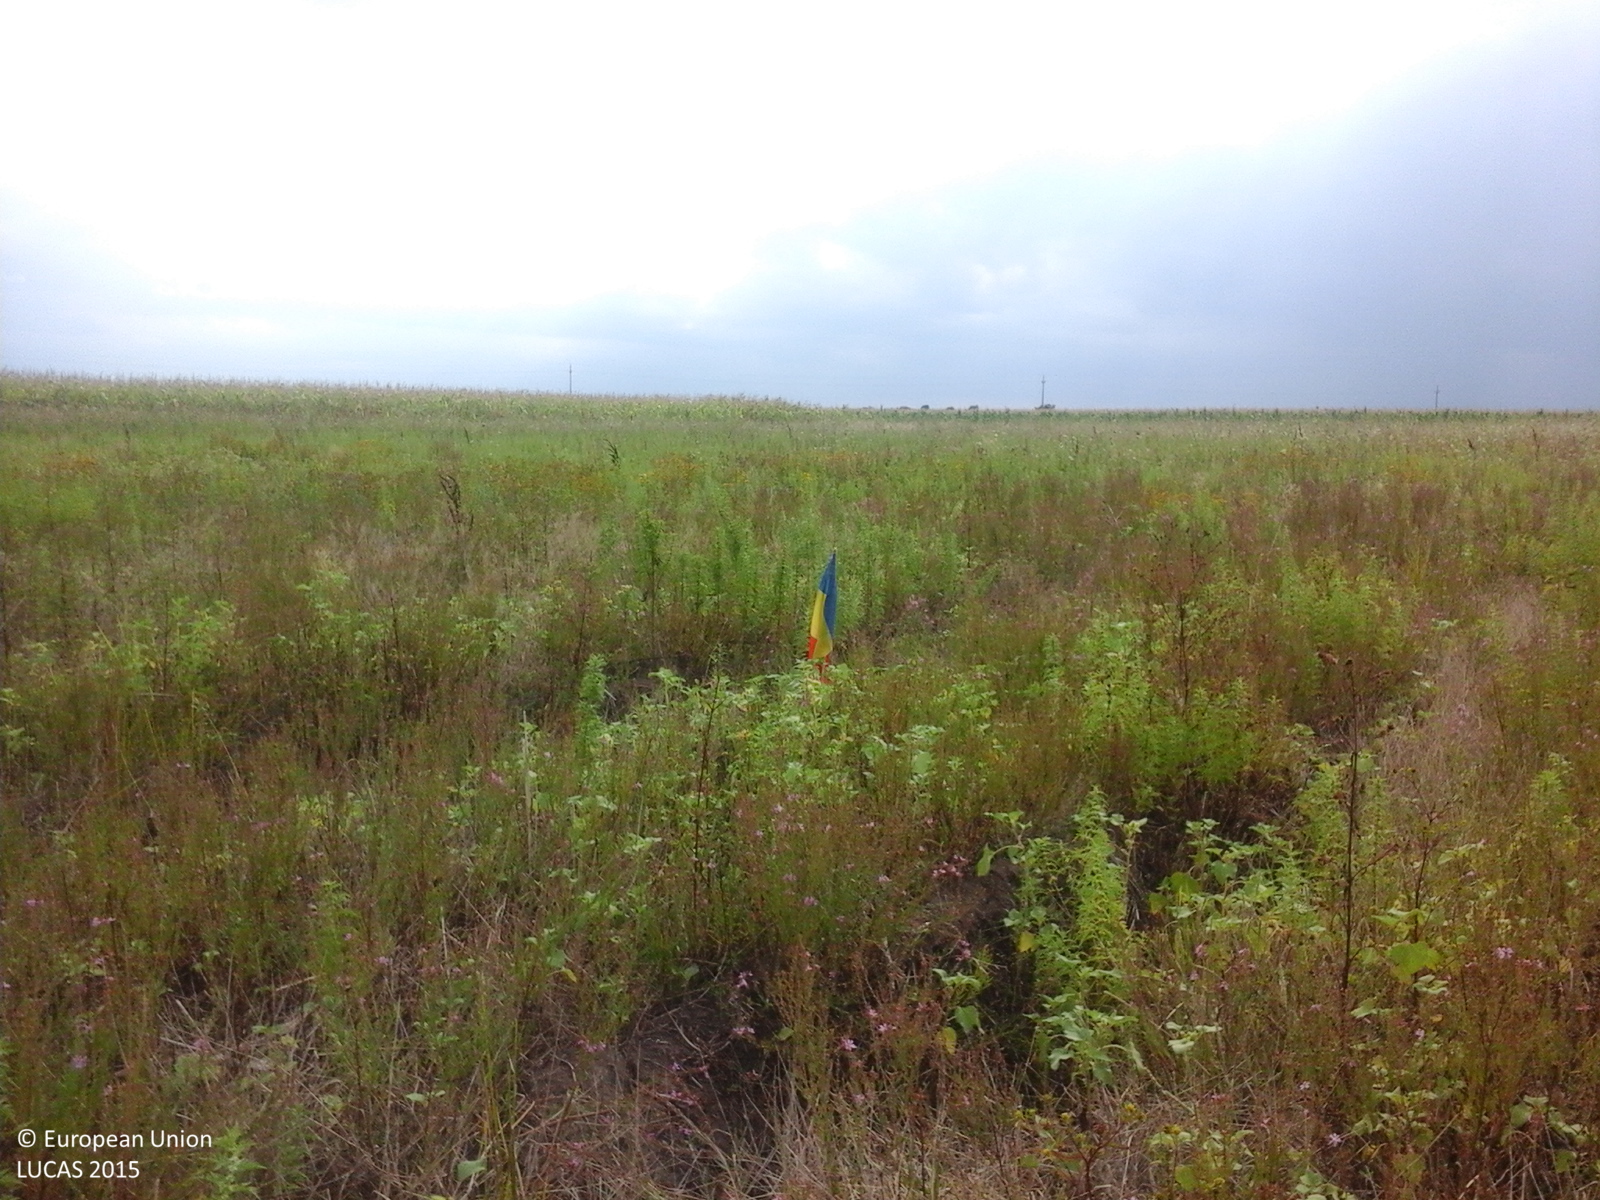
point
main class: Grassland
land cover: Spontaneously vegetated surfaces
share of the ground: > 75 %
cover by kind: herbaceous plants 100 %
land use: Agriculture (excluding fallow land and kitchen gardens)
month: August
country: RO
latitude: 45.6239
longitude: 21.4603
